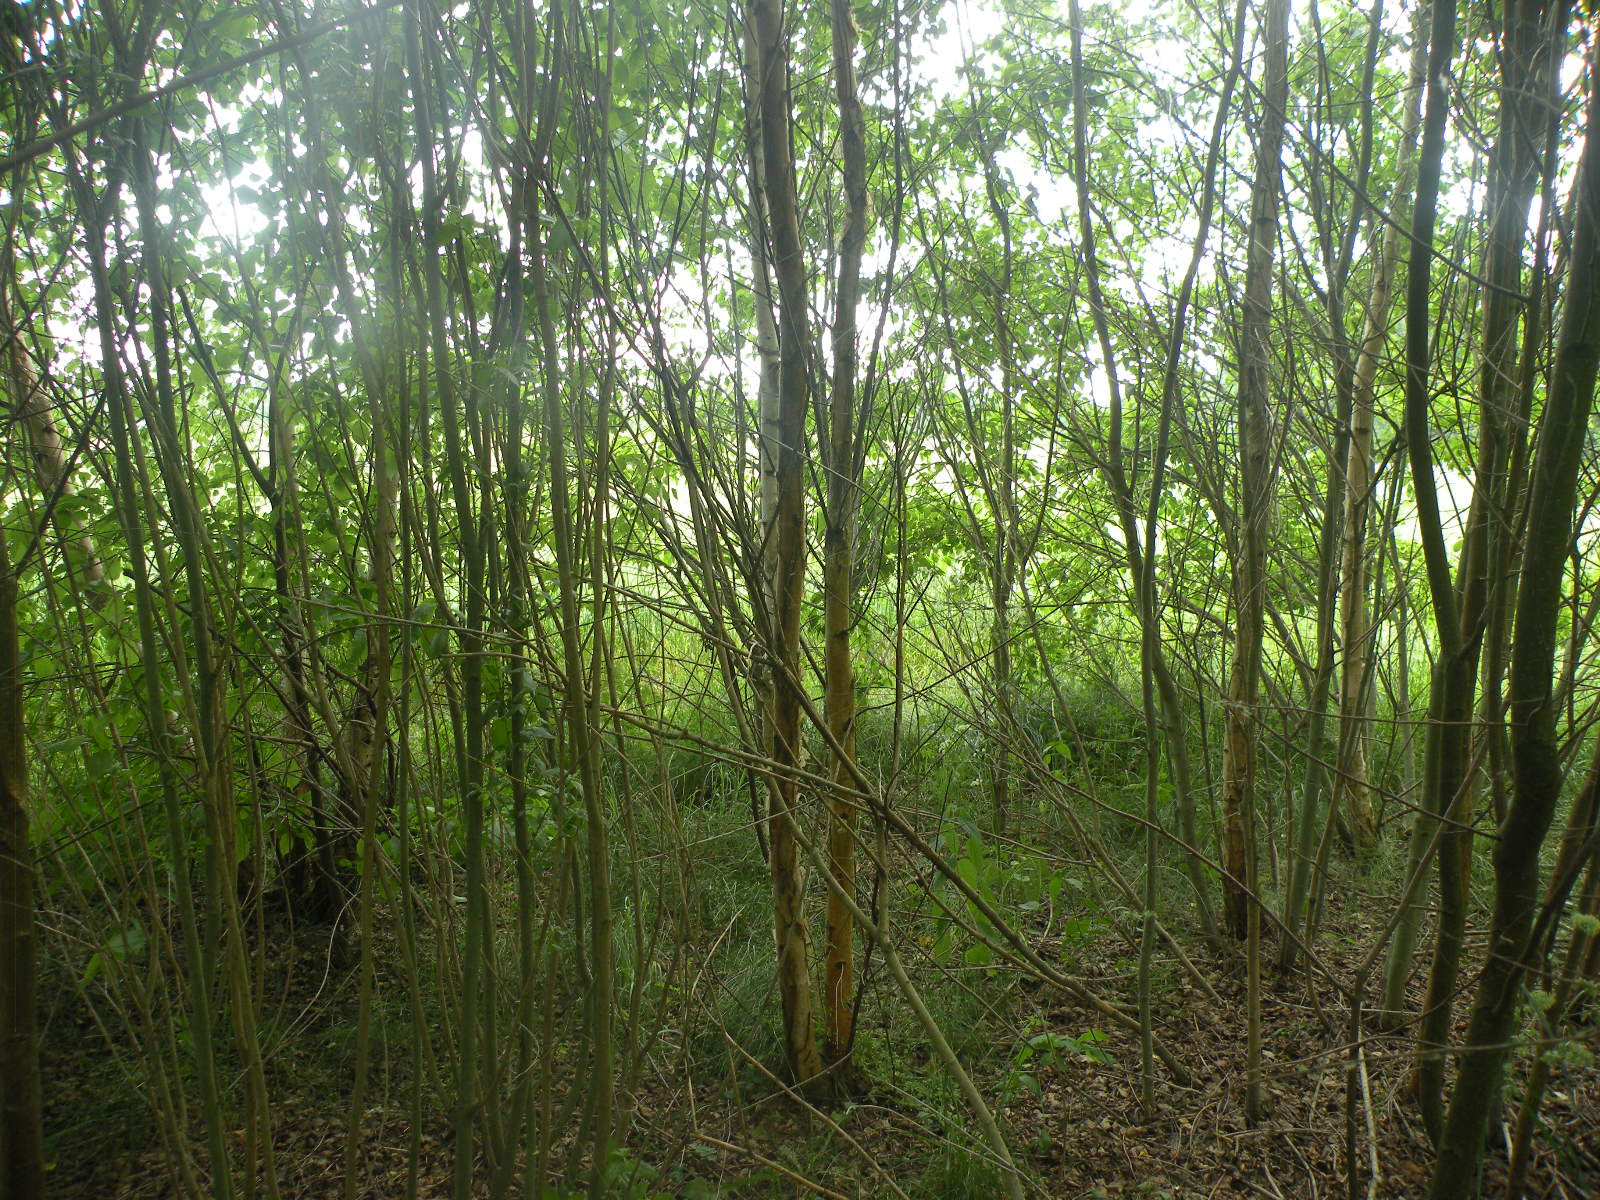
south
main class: Woodland
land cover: Broadleaved woodland
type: non-riverine alder, birch or aspen forest
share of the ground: > 75 %
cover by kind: broadleaved forest trees 95 %, herbaceous plants 5 %
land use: Forestry
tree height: < 5 m
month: June
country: LV
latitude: 55.9687
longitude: 26.6739
